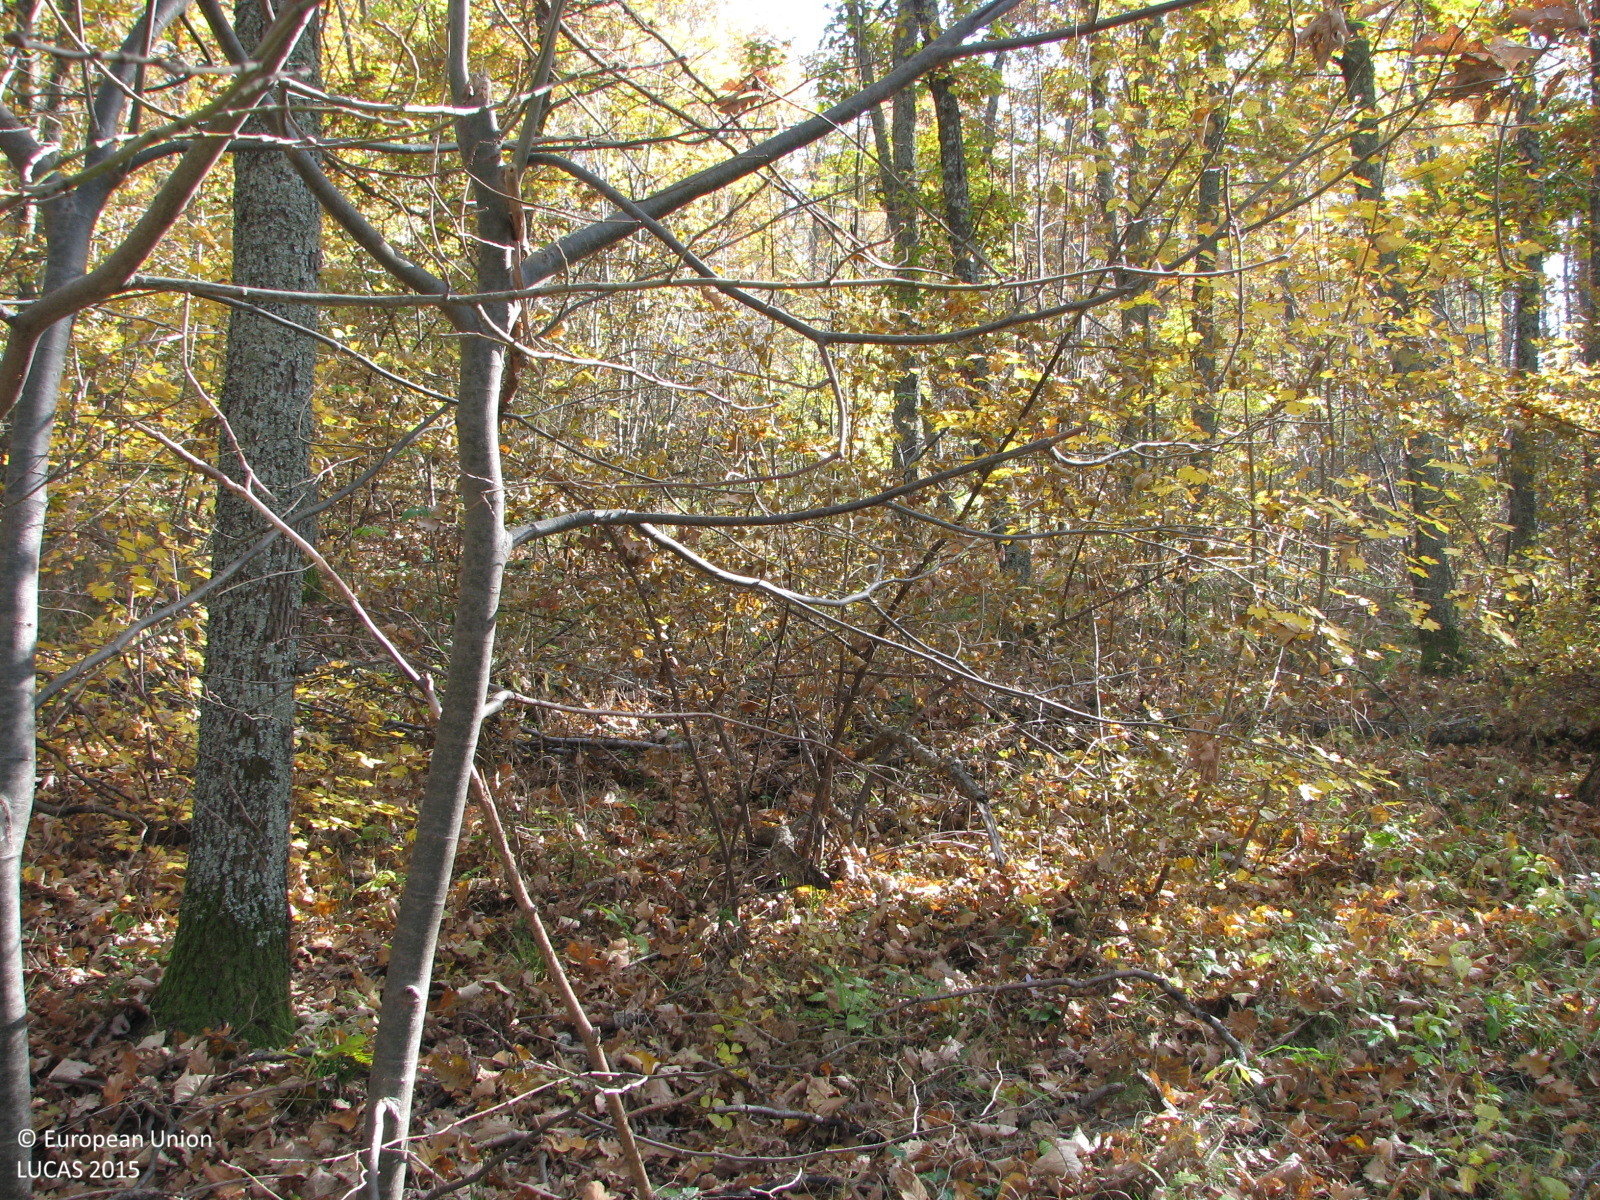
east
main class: Woodland
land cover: Broadleaved woodland
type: mesophytic deciduous forest
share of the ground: 50 - 75 %
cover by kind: broadleaved forest trees 65 %, herbaceous plants 25 %, shrubs 10 %
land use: Forestry
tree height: > 5 m
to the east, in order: Broadleaved woodland; Tracks; Broadleaved woodland; Tracks; Broadleaved woodland
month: November
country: BG
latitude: 42.0316
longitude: 26.3528
